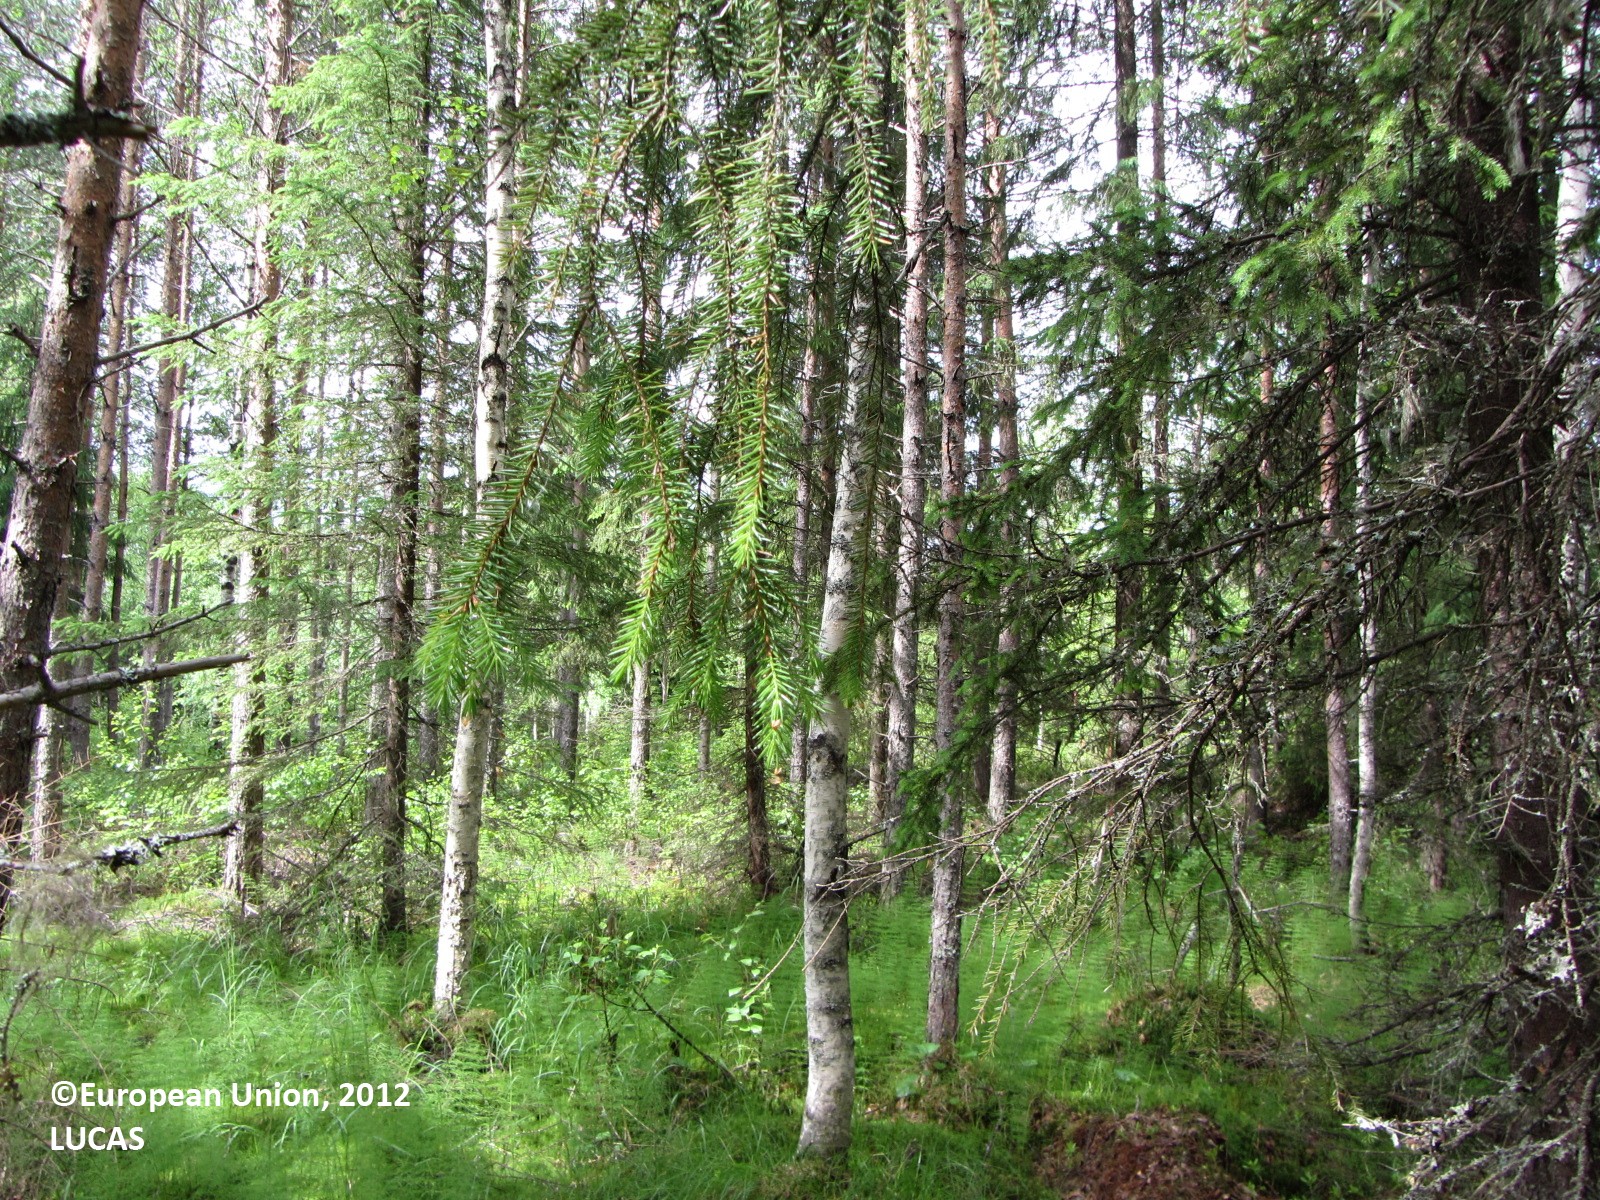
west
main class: Woodland
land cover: Other mixed woodland
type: boreal forest
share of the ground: > 75 %
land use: Forestry
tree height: > 5 m
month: June
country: FI
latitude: 62.6270
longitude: 25.0134
